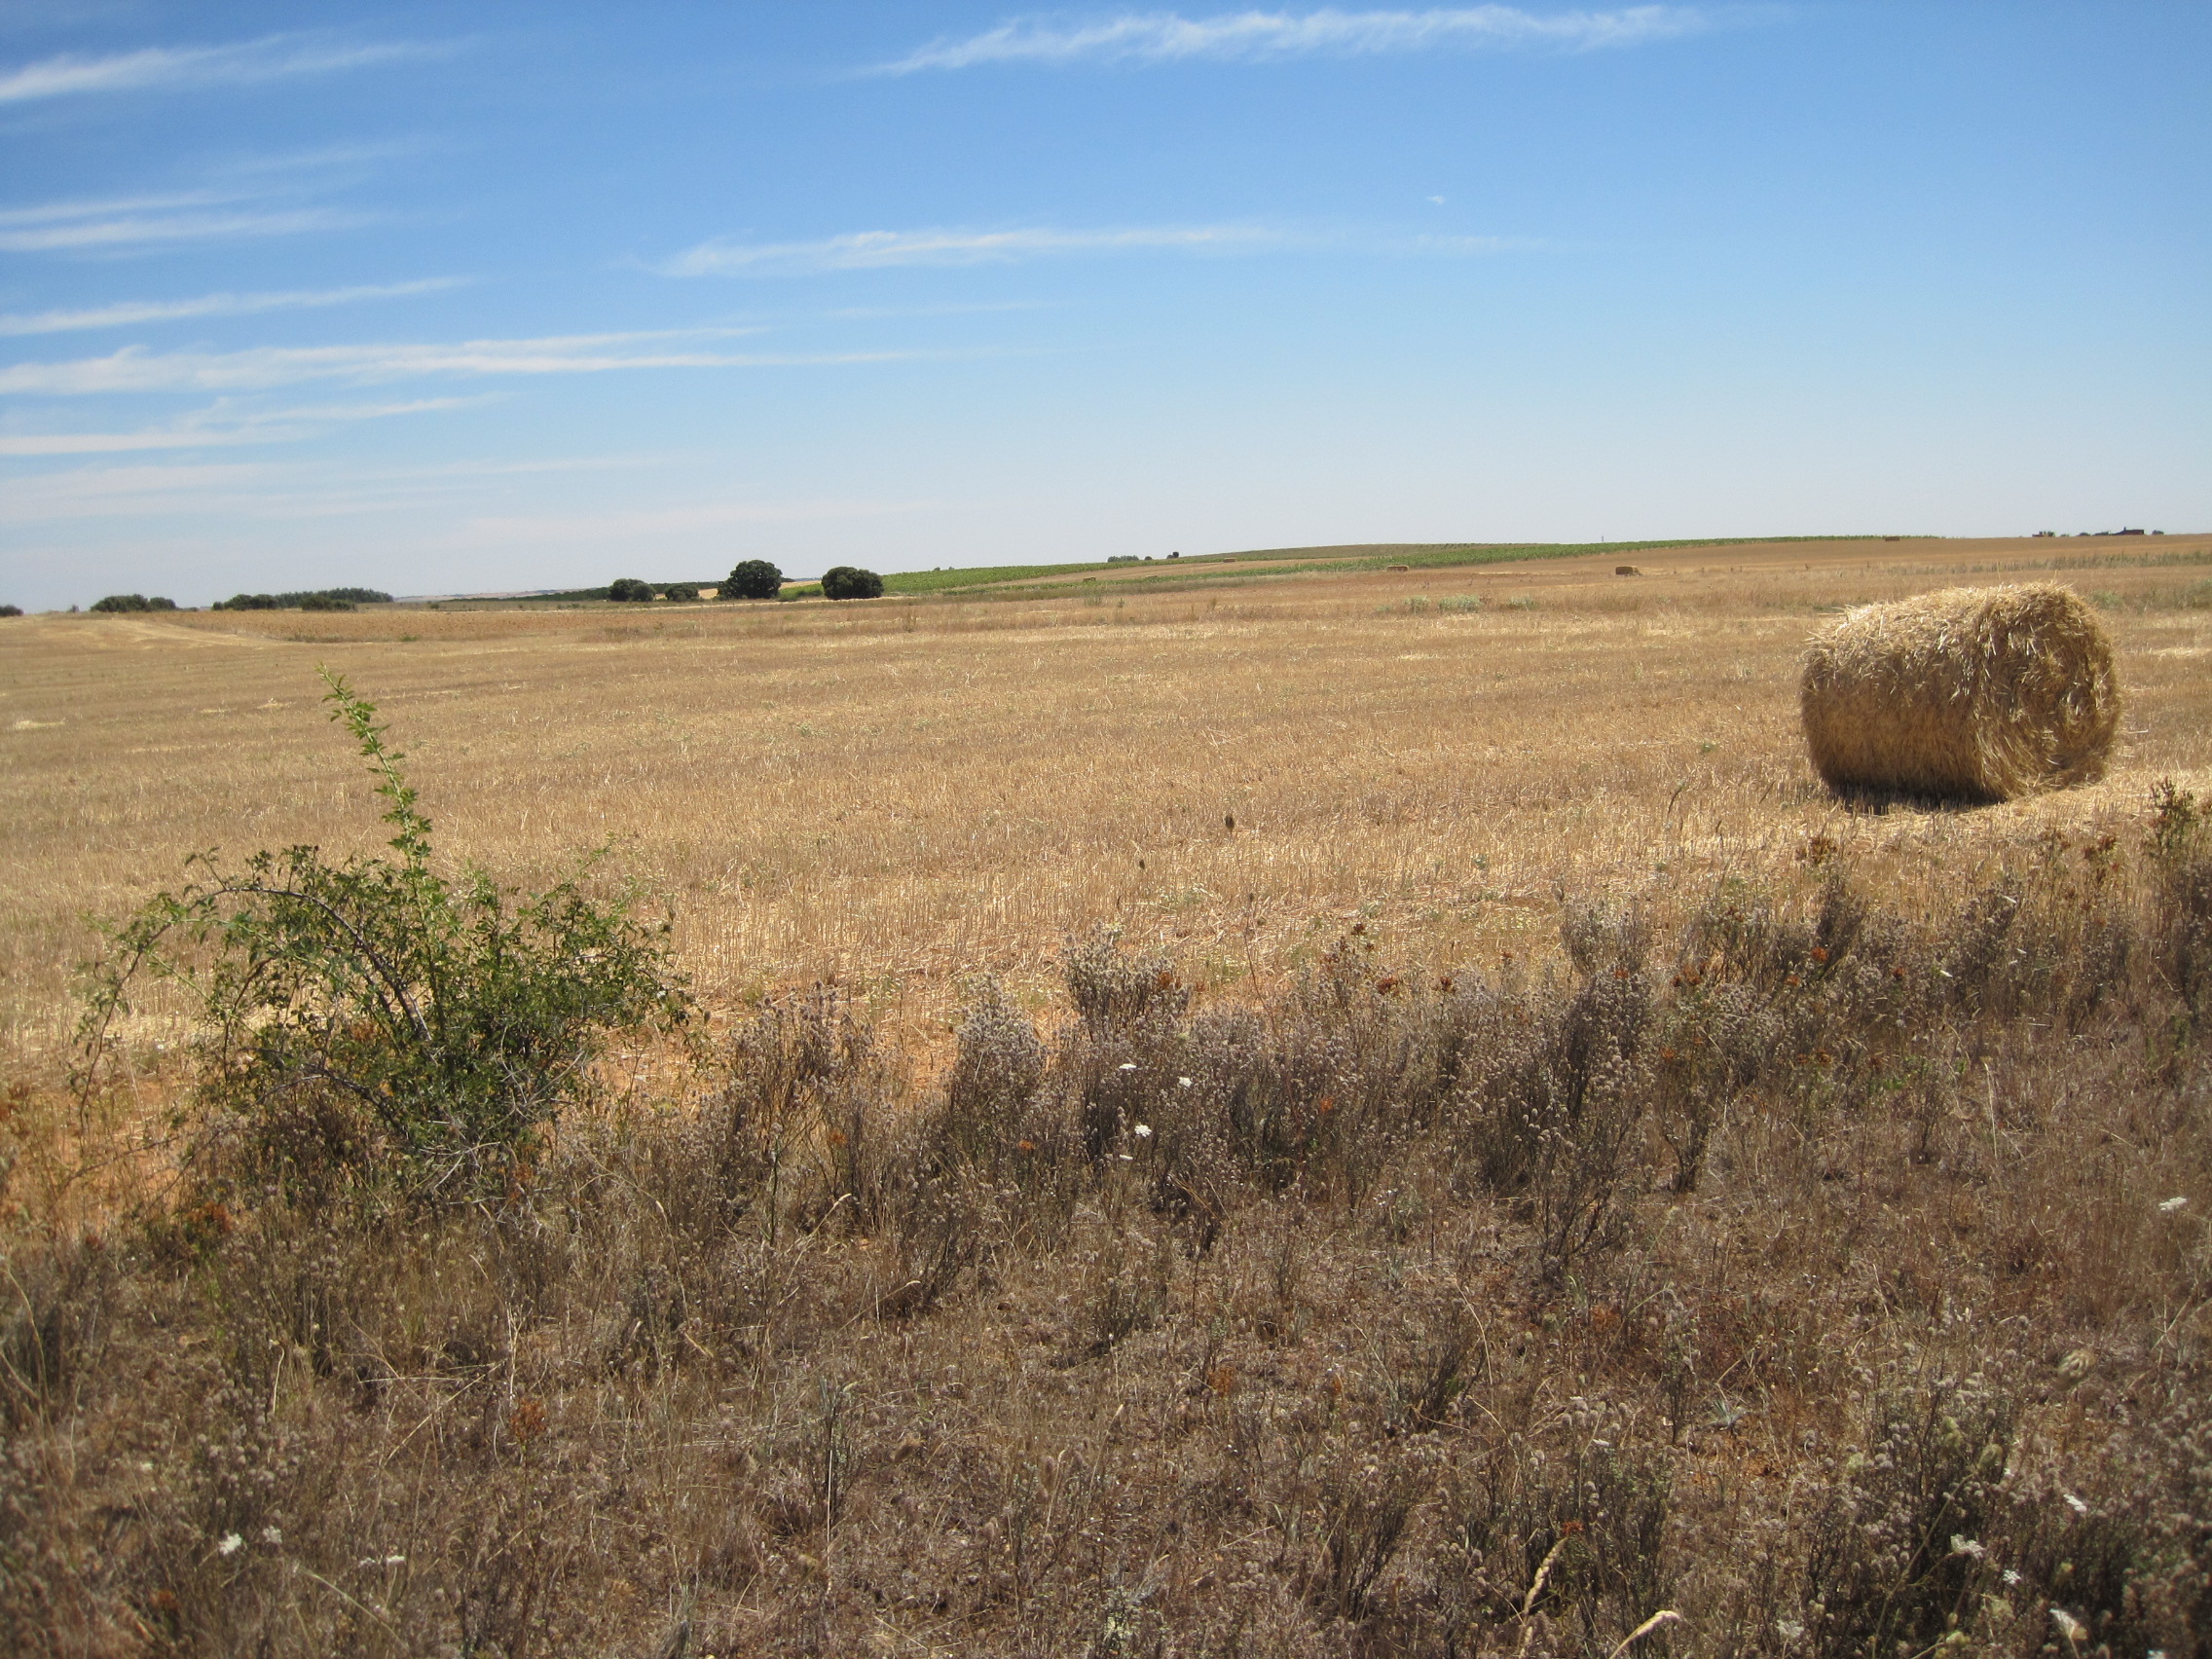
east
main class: Shrubland
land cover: Shrubland with sparse tree cover
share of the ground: 25 - 50 %
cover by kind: shrubs 50 %, herbaceous plants 35 %, unconsolidated bare surface 10 %, broadleaved forest trees 5 %
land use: Abandoned areas
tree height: < 5 m
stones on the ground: < 10 %
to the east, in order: Shrubland with sparse tree cover; Barley; Grass margins; Barley; Spontaneously vegetated surfaces; Other bare soil; Spontaneously vegetated surfaces; Other bare soil
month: July
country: ES
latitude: 42.1210
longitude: -5.6849
